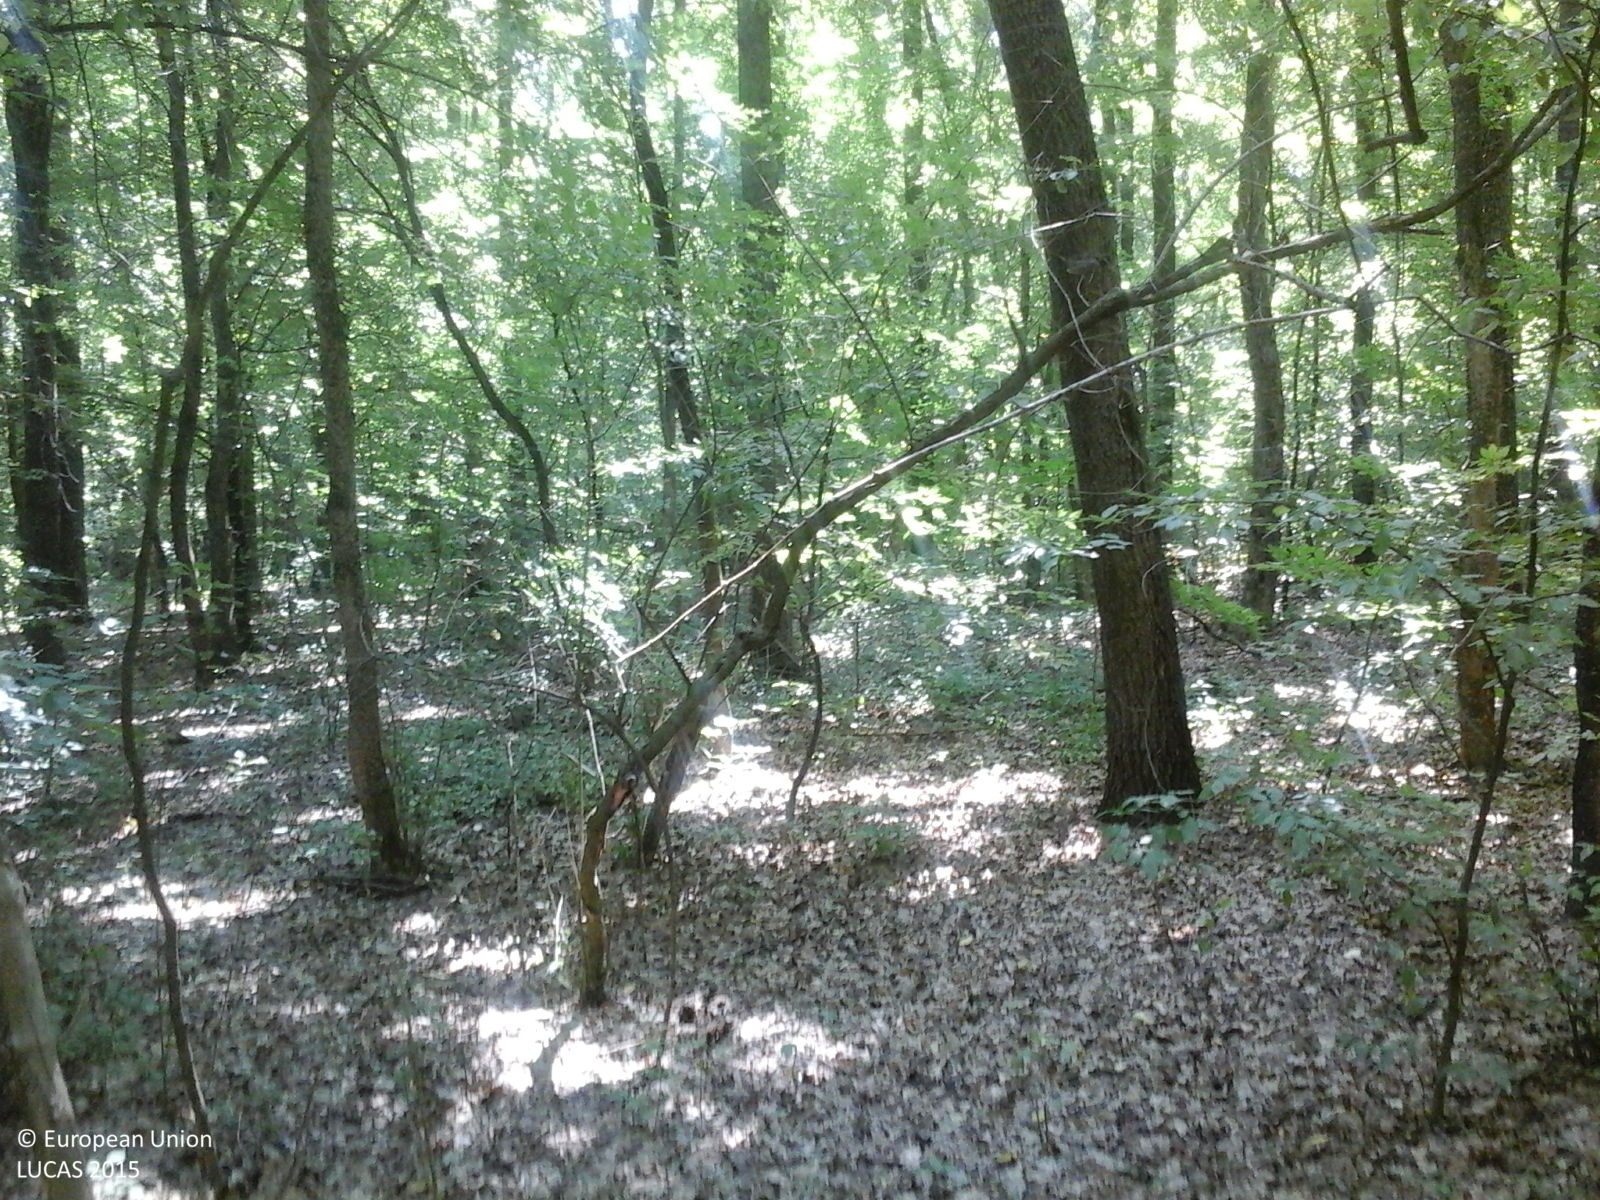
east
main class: Woodland
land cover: Broadleaved woodland
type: beech forest
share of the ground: > 75 %
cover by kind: broadleaved forest trees 100 %
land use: Forestry
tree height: > 5 m
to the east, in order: Broadleaved woodland; Grassland with sparse tree/shrub cover; Tracks; Grassland with sparse tree/shrub cover; Broadleaved woodland
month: June
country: RO
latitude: 46.6983
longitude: 27.2767
